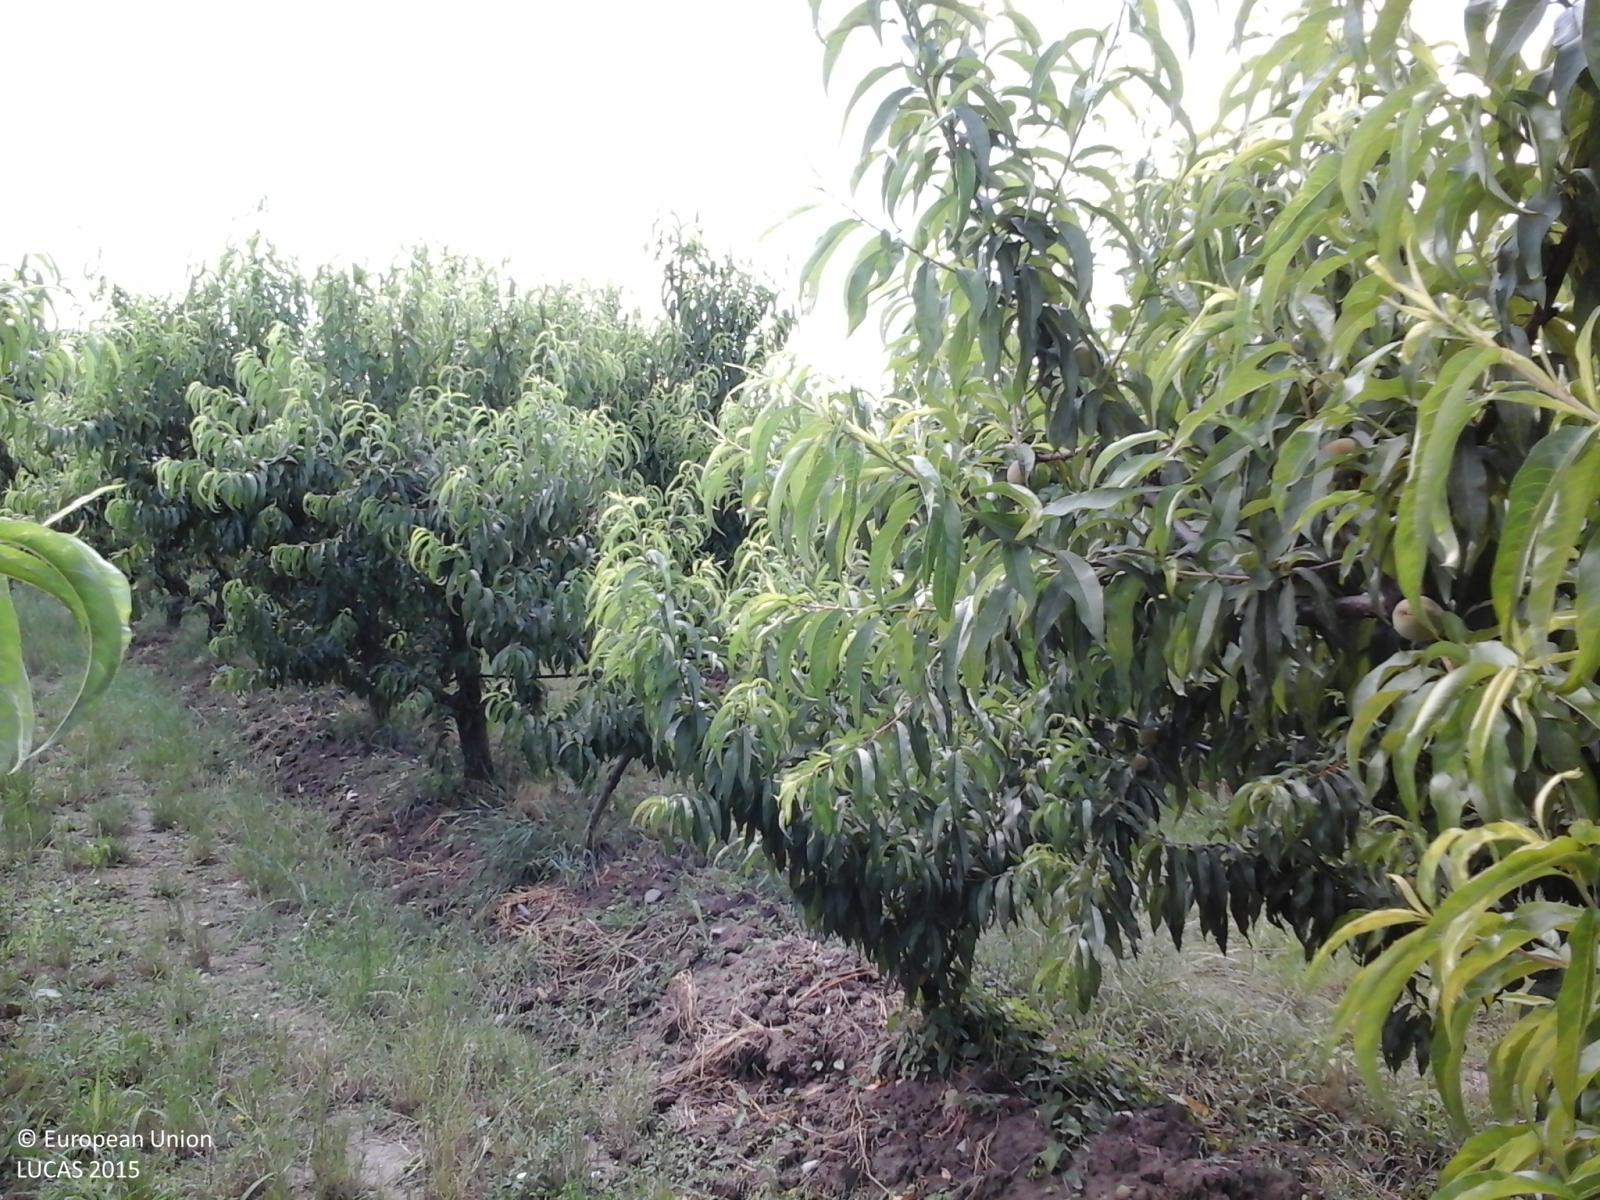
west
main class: Cropland
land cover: Other fruit trees and berries
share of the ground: 50 - 75 %
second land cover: Grassland without tree/shrub cover
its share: > 75 %
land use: Agriculture (excluding fallow land and kitchen gardens)
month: June
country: IT
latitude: 44.2839
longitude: 11.6128
